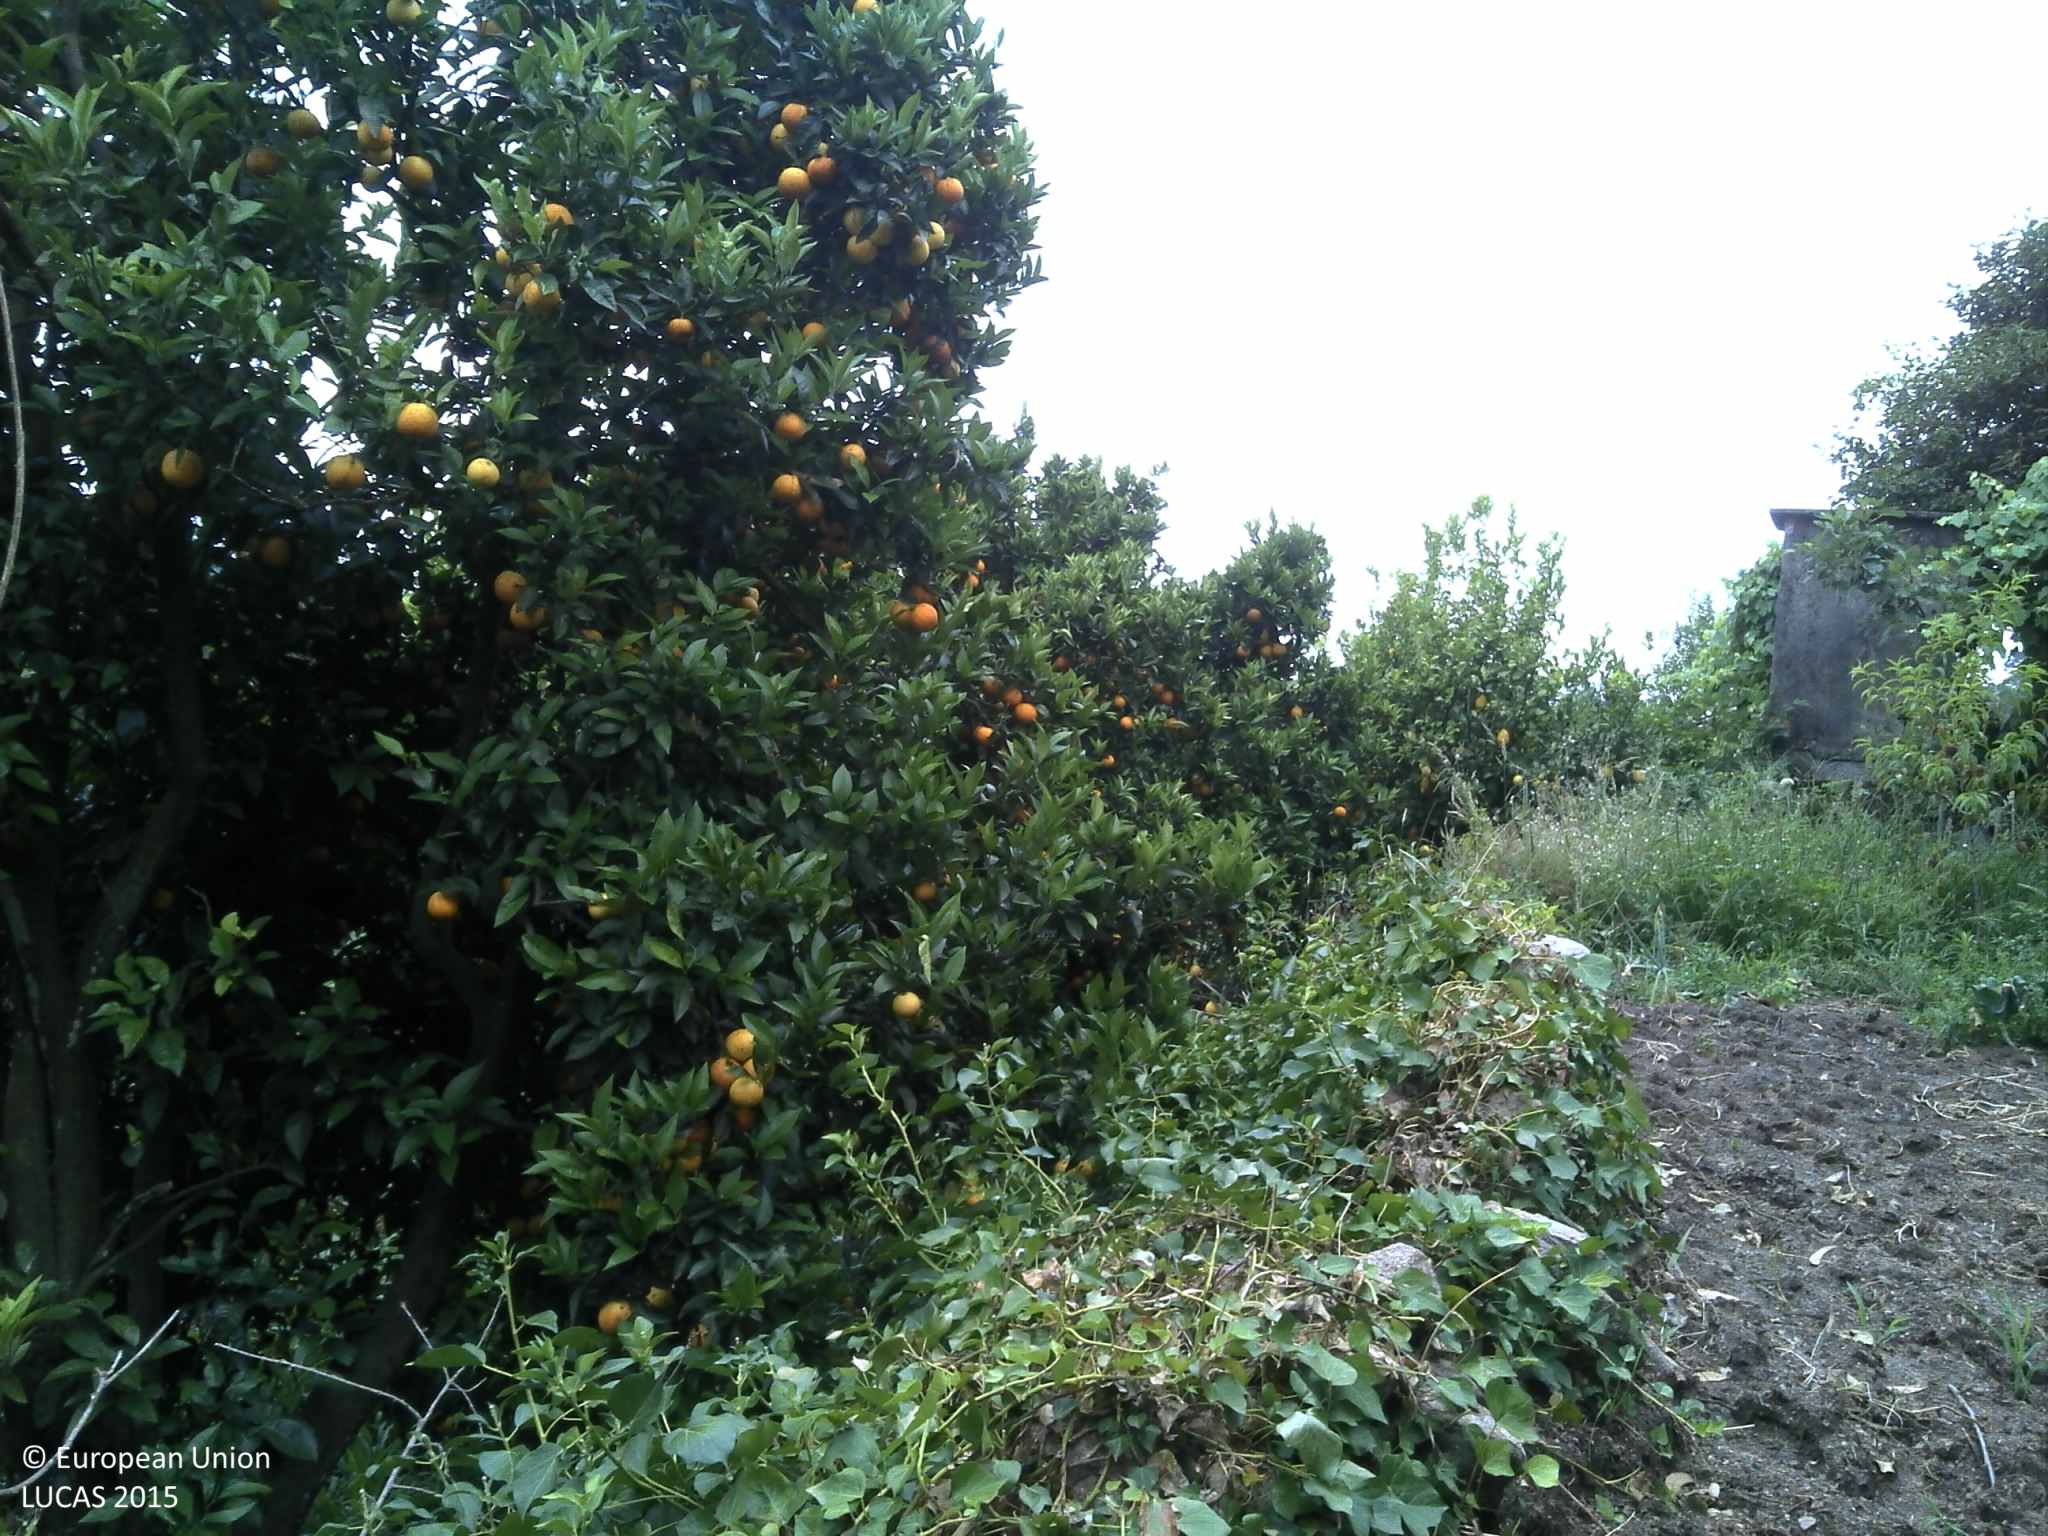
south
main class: Grassland
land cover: Grassland without tree/shrub cover
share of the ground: 50 - 75 %
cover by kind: herbaceous plants 75 %, unconsolidated bare surface 25 %
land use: Agriculture (excluding fallow land and kitchen gardens)
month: June
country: PT
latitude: 40.7844
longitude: -8.3033
